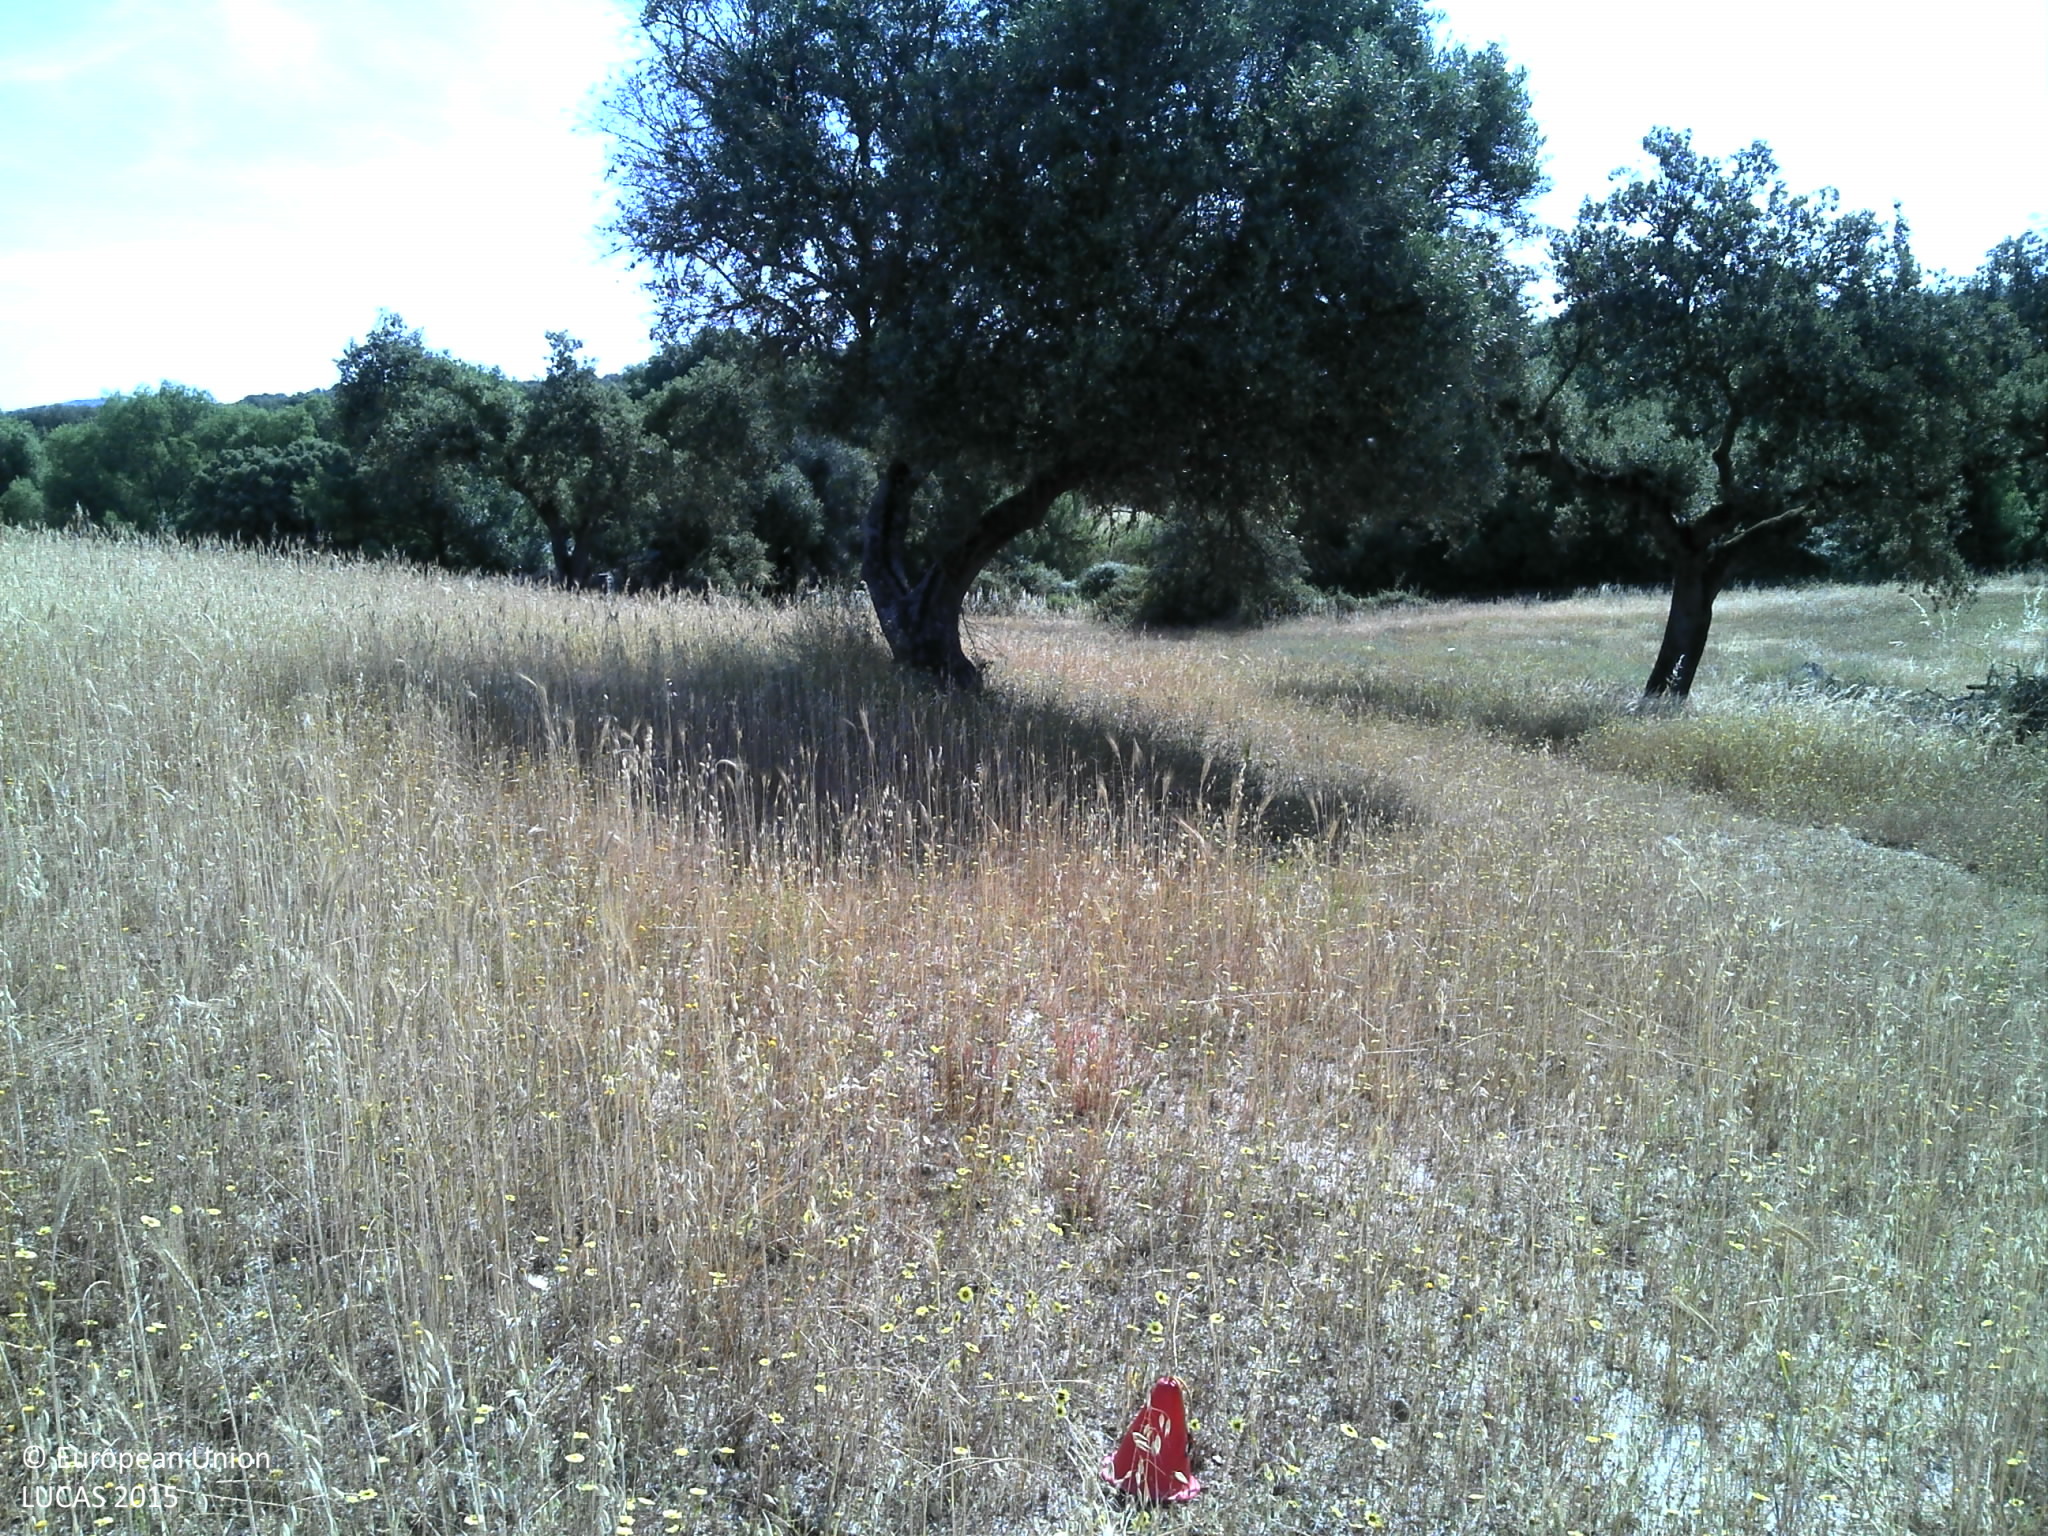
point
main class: Cropland
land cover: Olive groves
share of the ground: 10 - 25 %
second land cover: Triticale
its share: 10 - 25 %
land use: Agriculture (excluding fallow land and kitchen gardens)
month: May
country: PT
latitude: 39.0512
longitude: -7.5930
